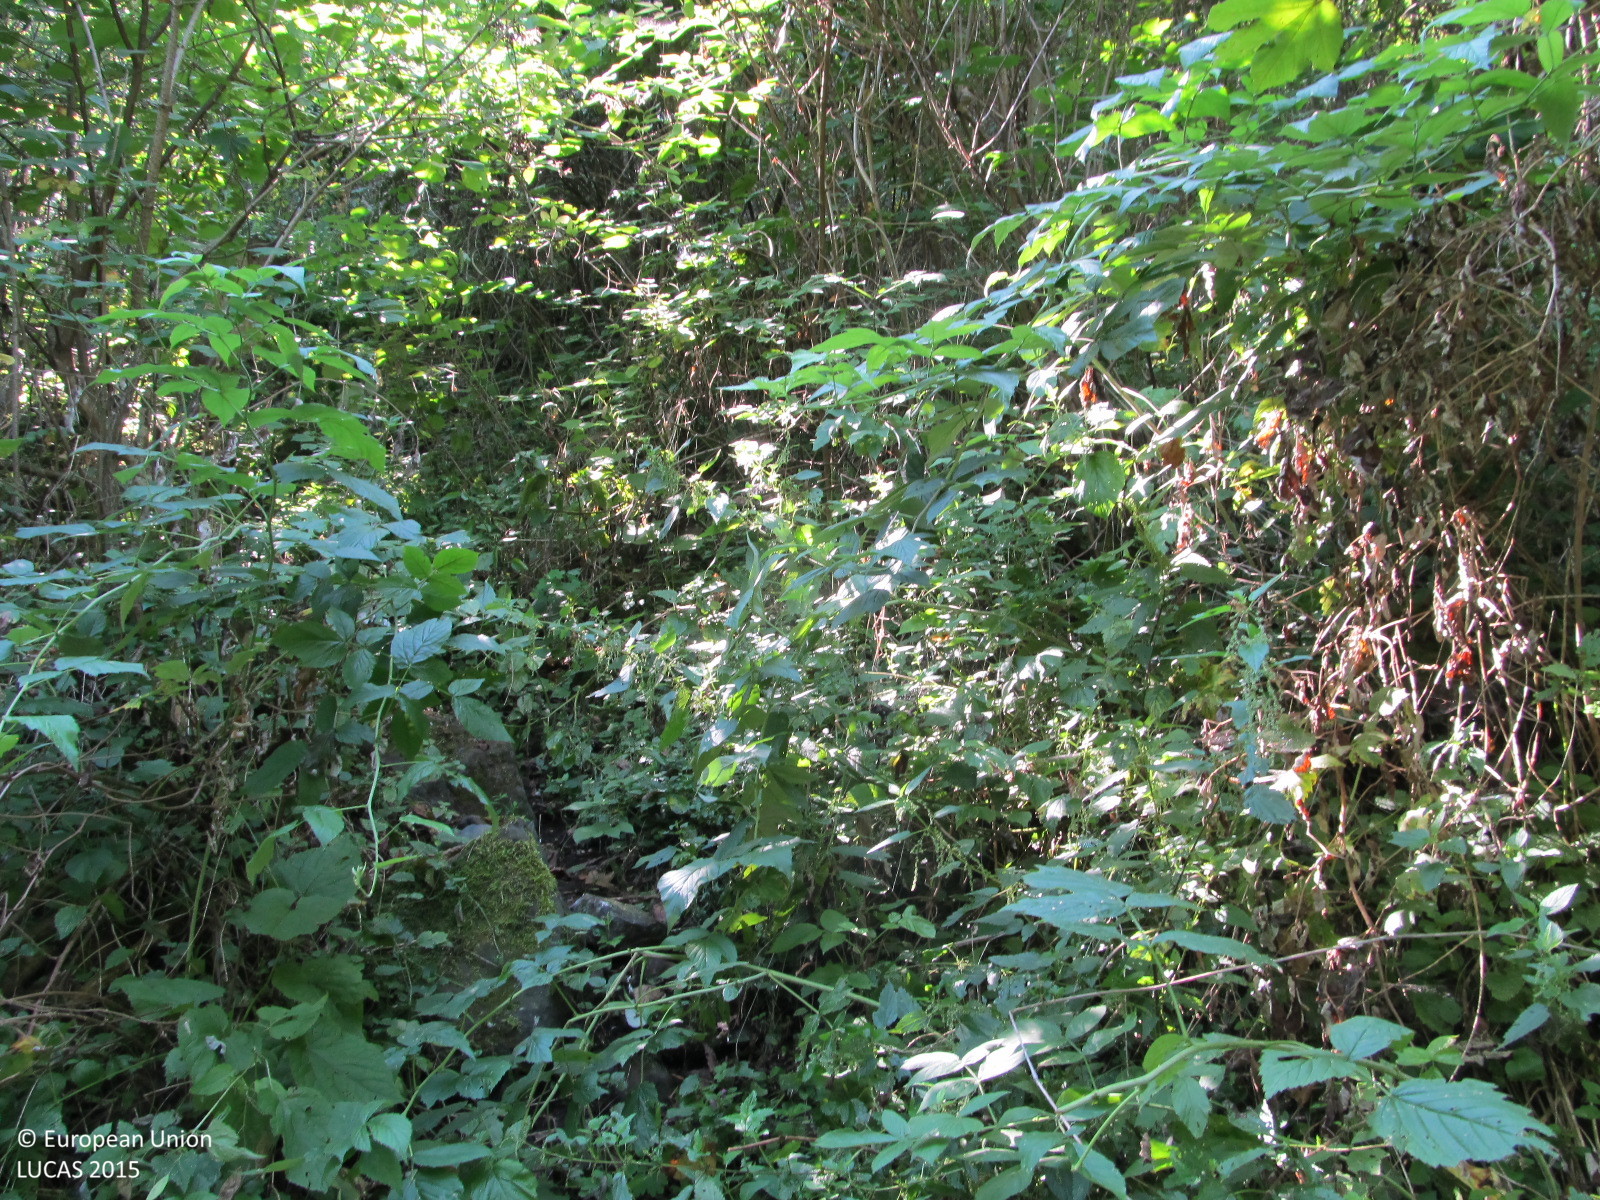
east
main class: Woodland
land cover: Broadleaved woodland
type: hemiboreal forest and nemoral coniferous forest and mixed broadleaved-coniferous forest
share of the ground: > 75 %
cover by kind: broadleaved forest trees 85 %, shrubs 5 %, herbaceous plants 5 %, unconsolidated bare surface 5 %
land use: Semi-natural and natural areas not in use
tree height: > 5 m
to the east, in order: Broadleaved woodland; Spruce dominated mixed woodland; Tracks; Broadleaved woodland; Shruby margins; Inland fresh running water; Broadleaved woodland
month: August
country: AT
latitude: 48.4520
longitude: 15.3973
